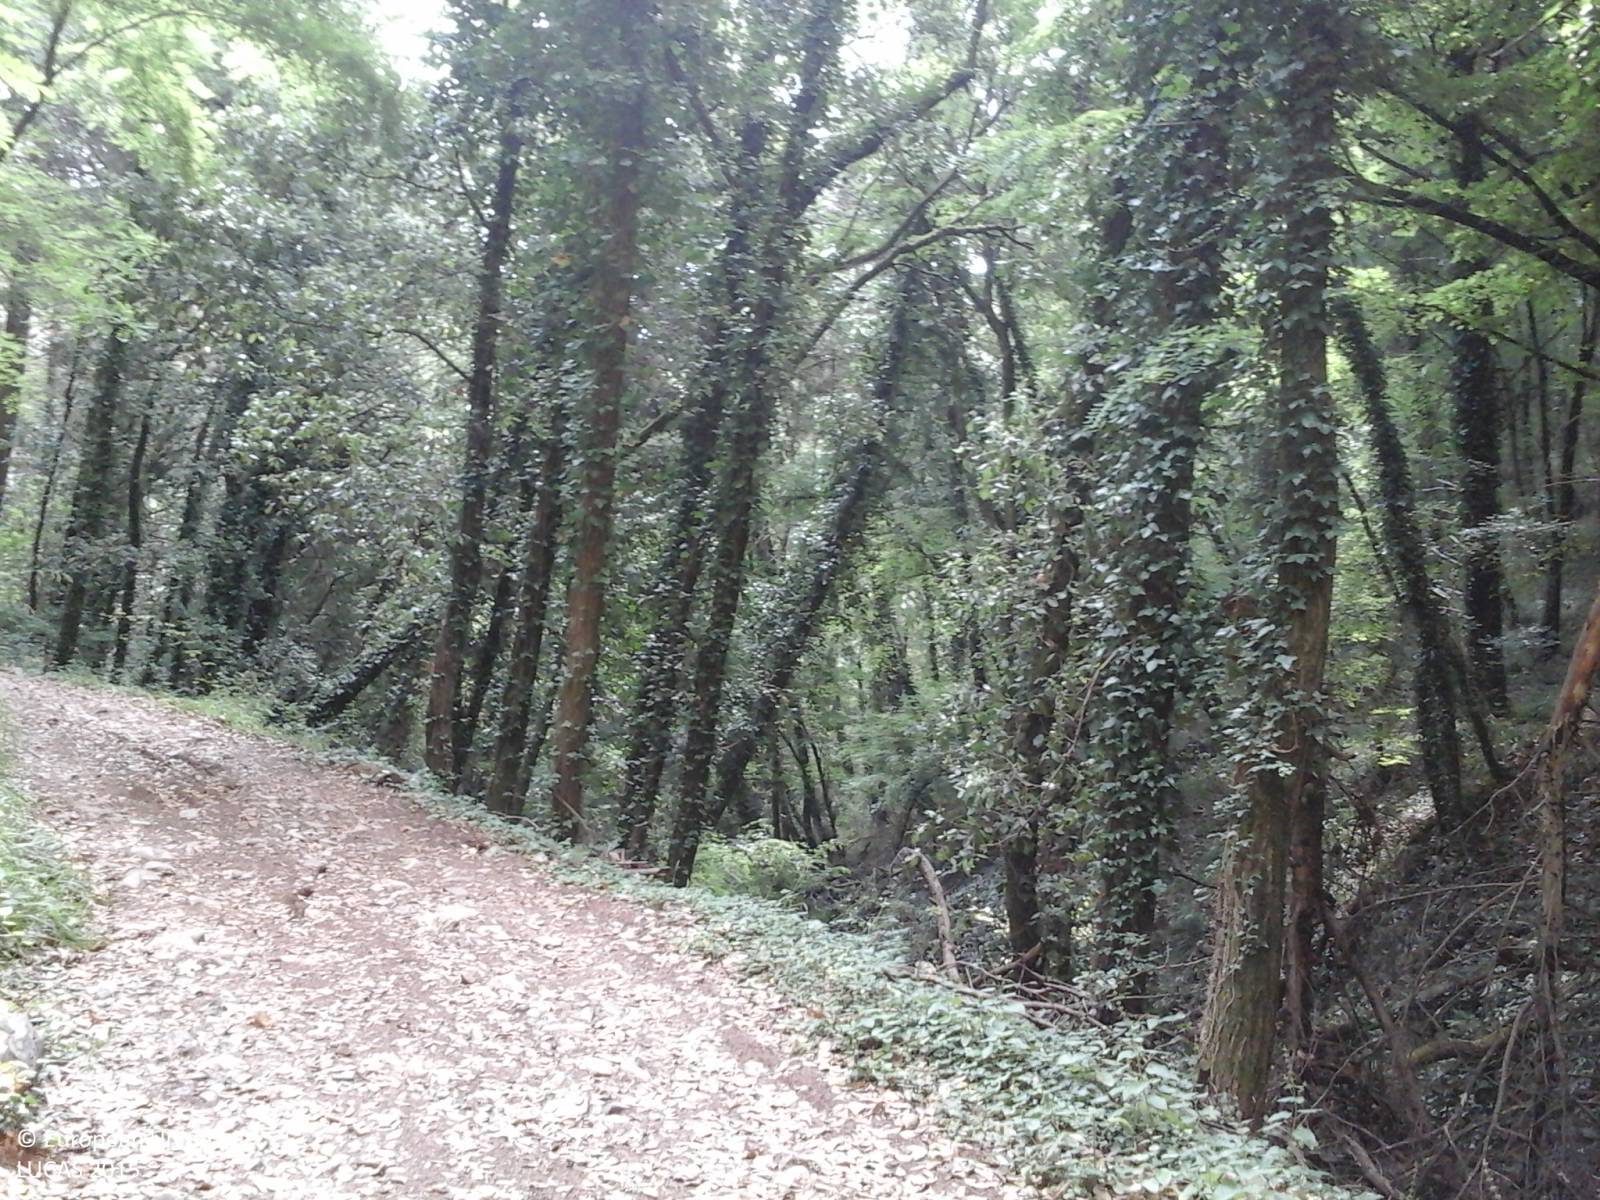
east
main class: Woodland
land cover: Broadleaved woodland
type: thermophilous deciduous forest
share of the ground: > 75 %
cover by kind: broadleaved forest trees 90 %, coniferous forest trees 10 %
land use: Forestry
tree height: < 5 m
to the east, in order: Broadleaved woodland
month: June
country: IT
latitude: 41.1667
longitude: 13.9293
